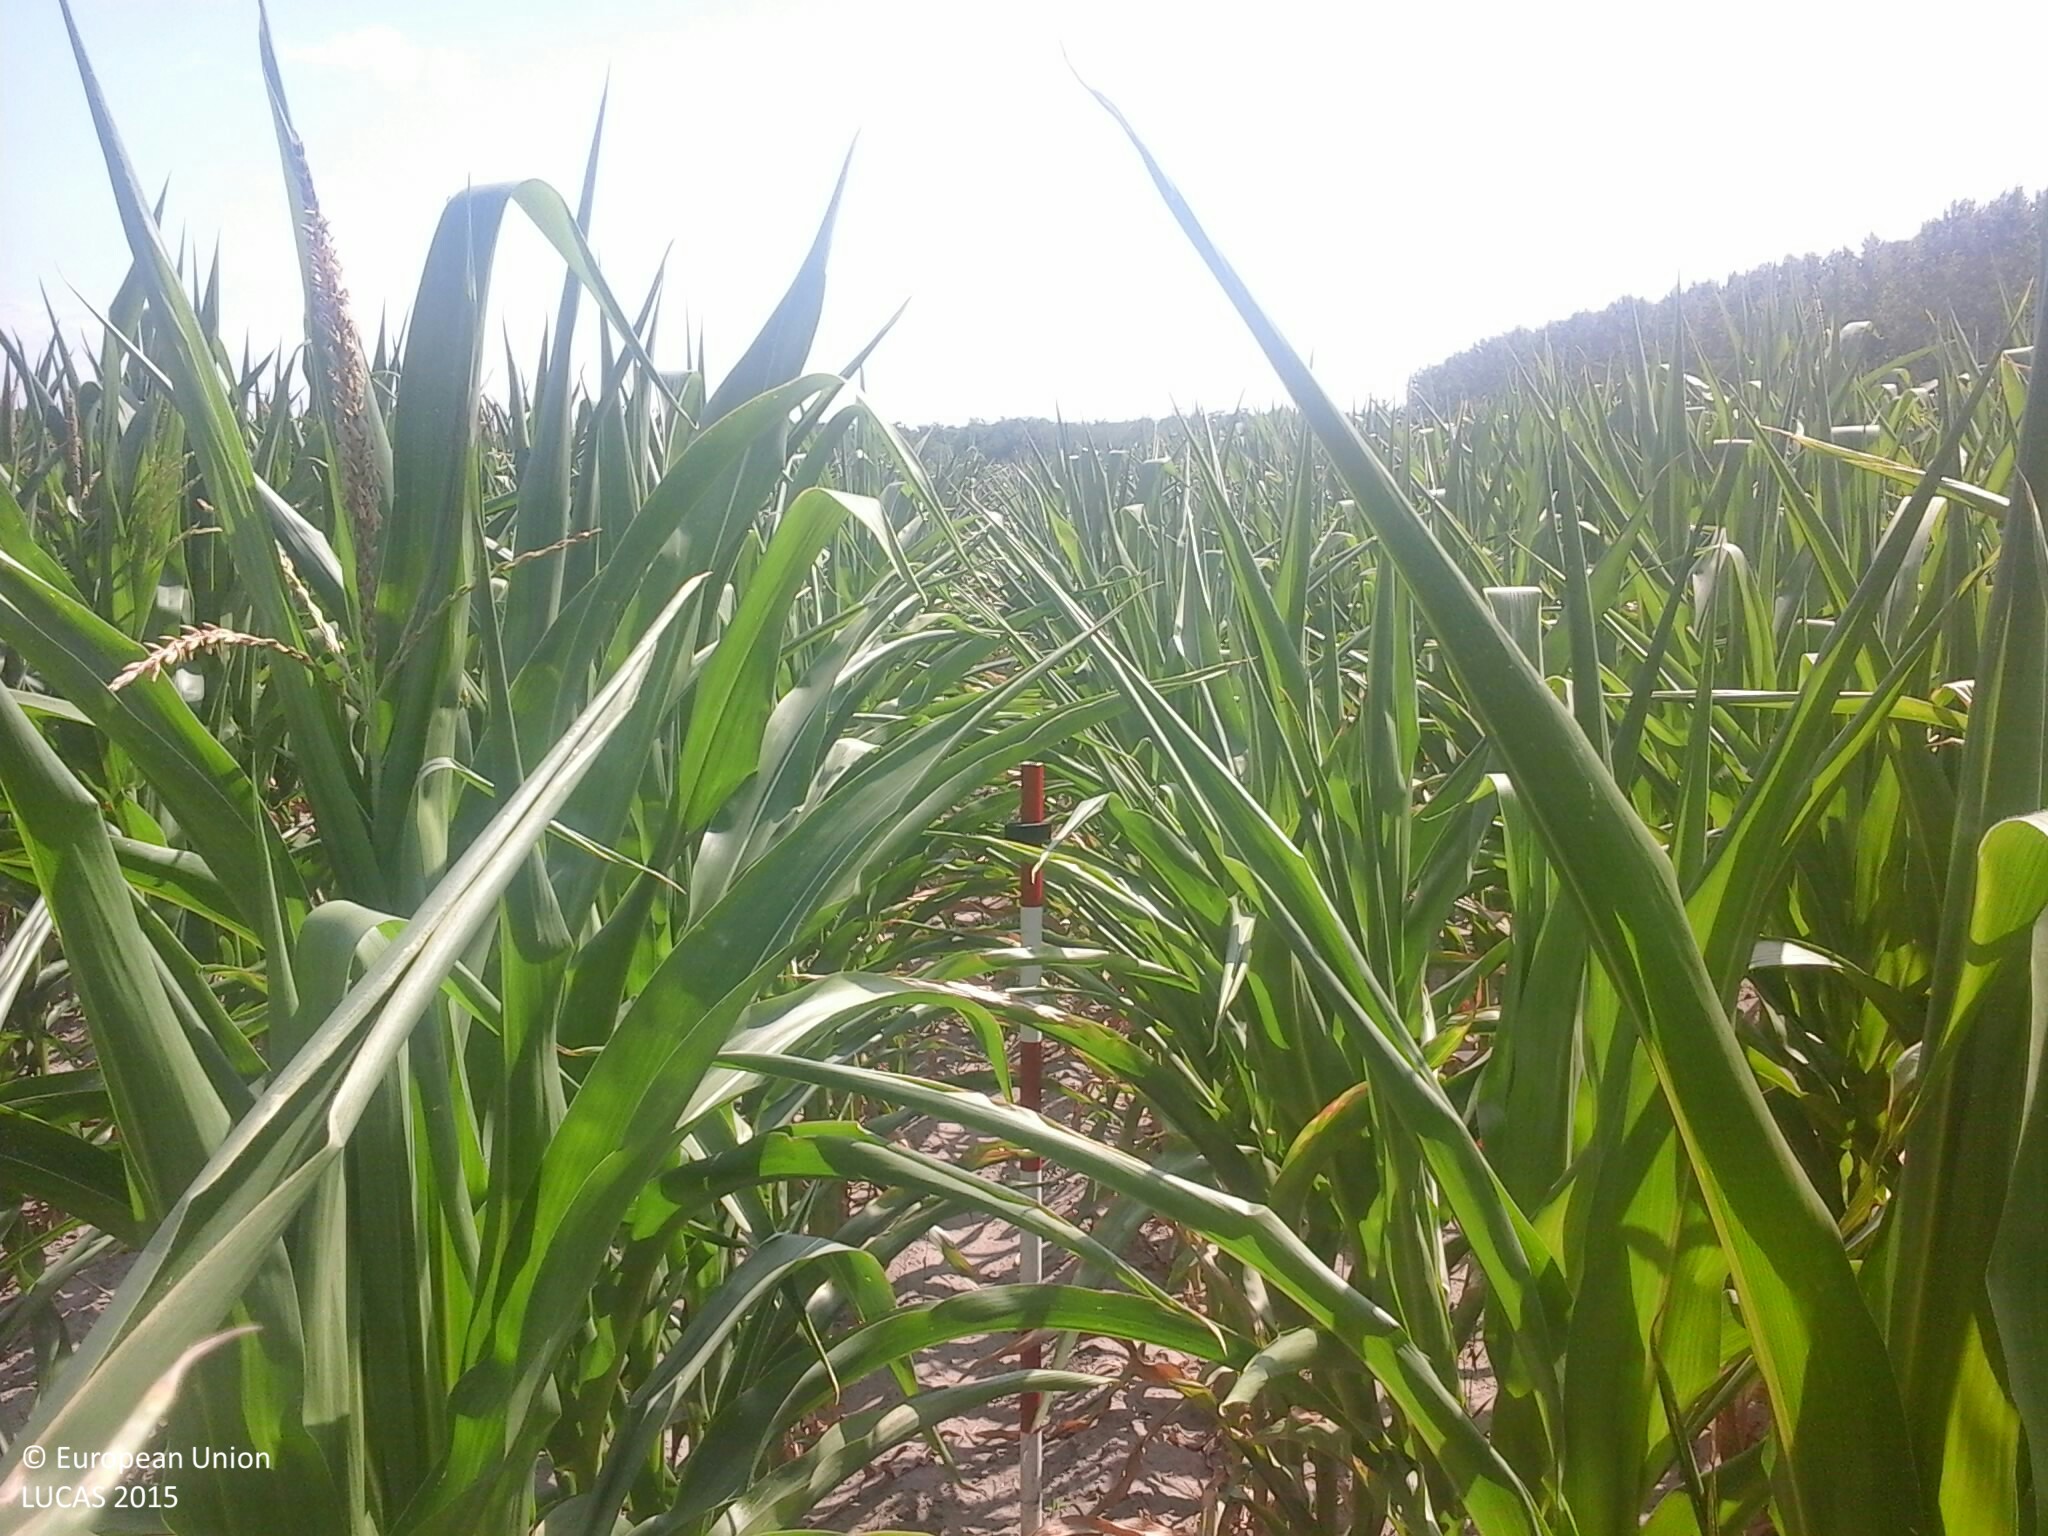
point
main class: Cropland
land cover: Maize
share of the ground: 50 - 75 %
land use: Agriculture (excluding fallow land and kitchen gardens)
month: July
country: HU
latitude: 47.8461
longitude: 22.2555
